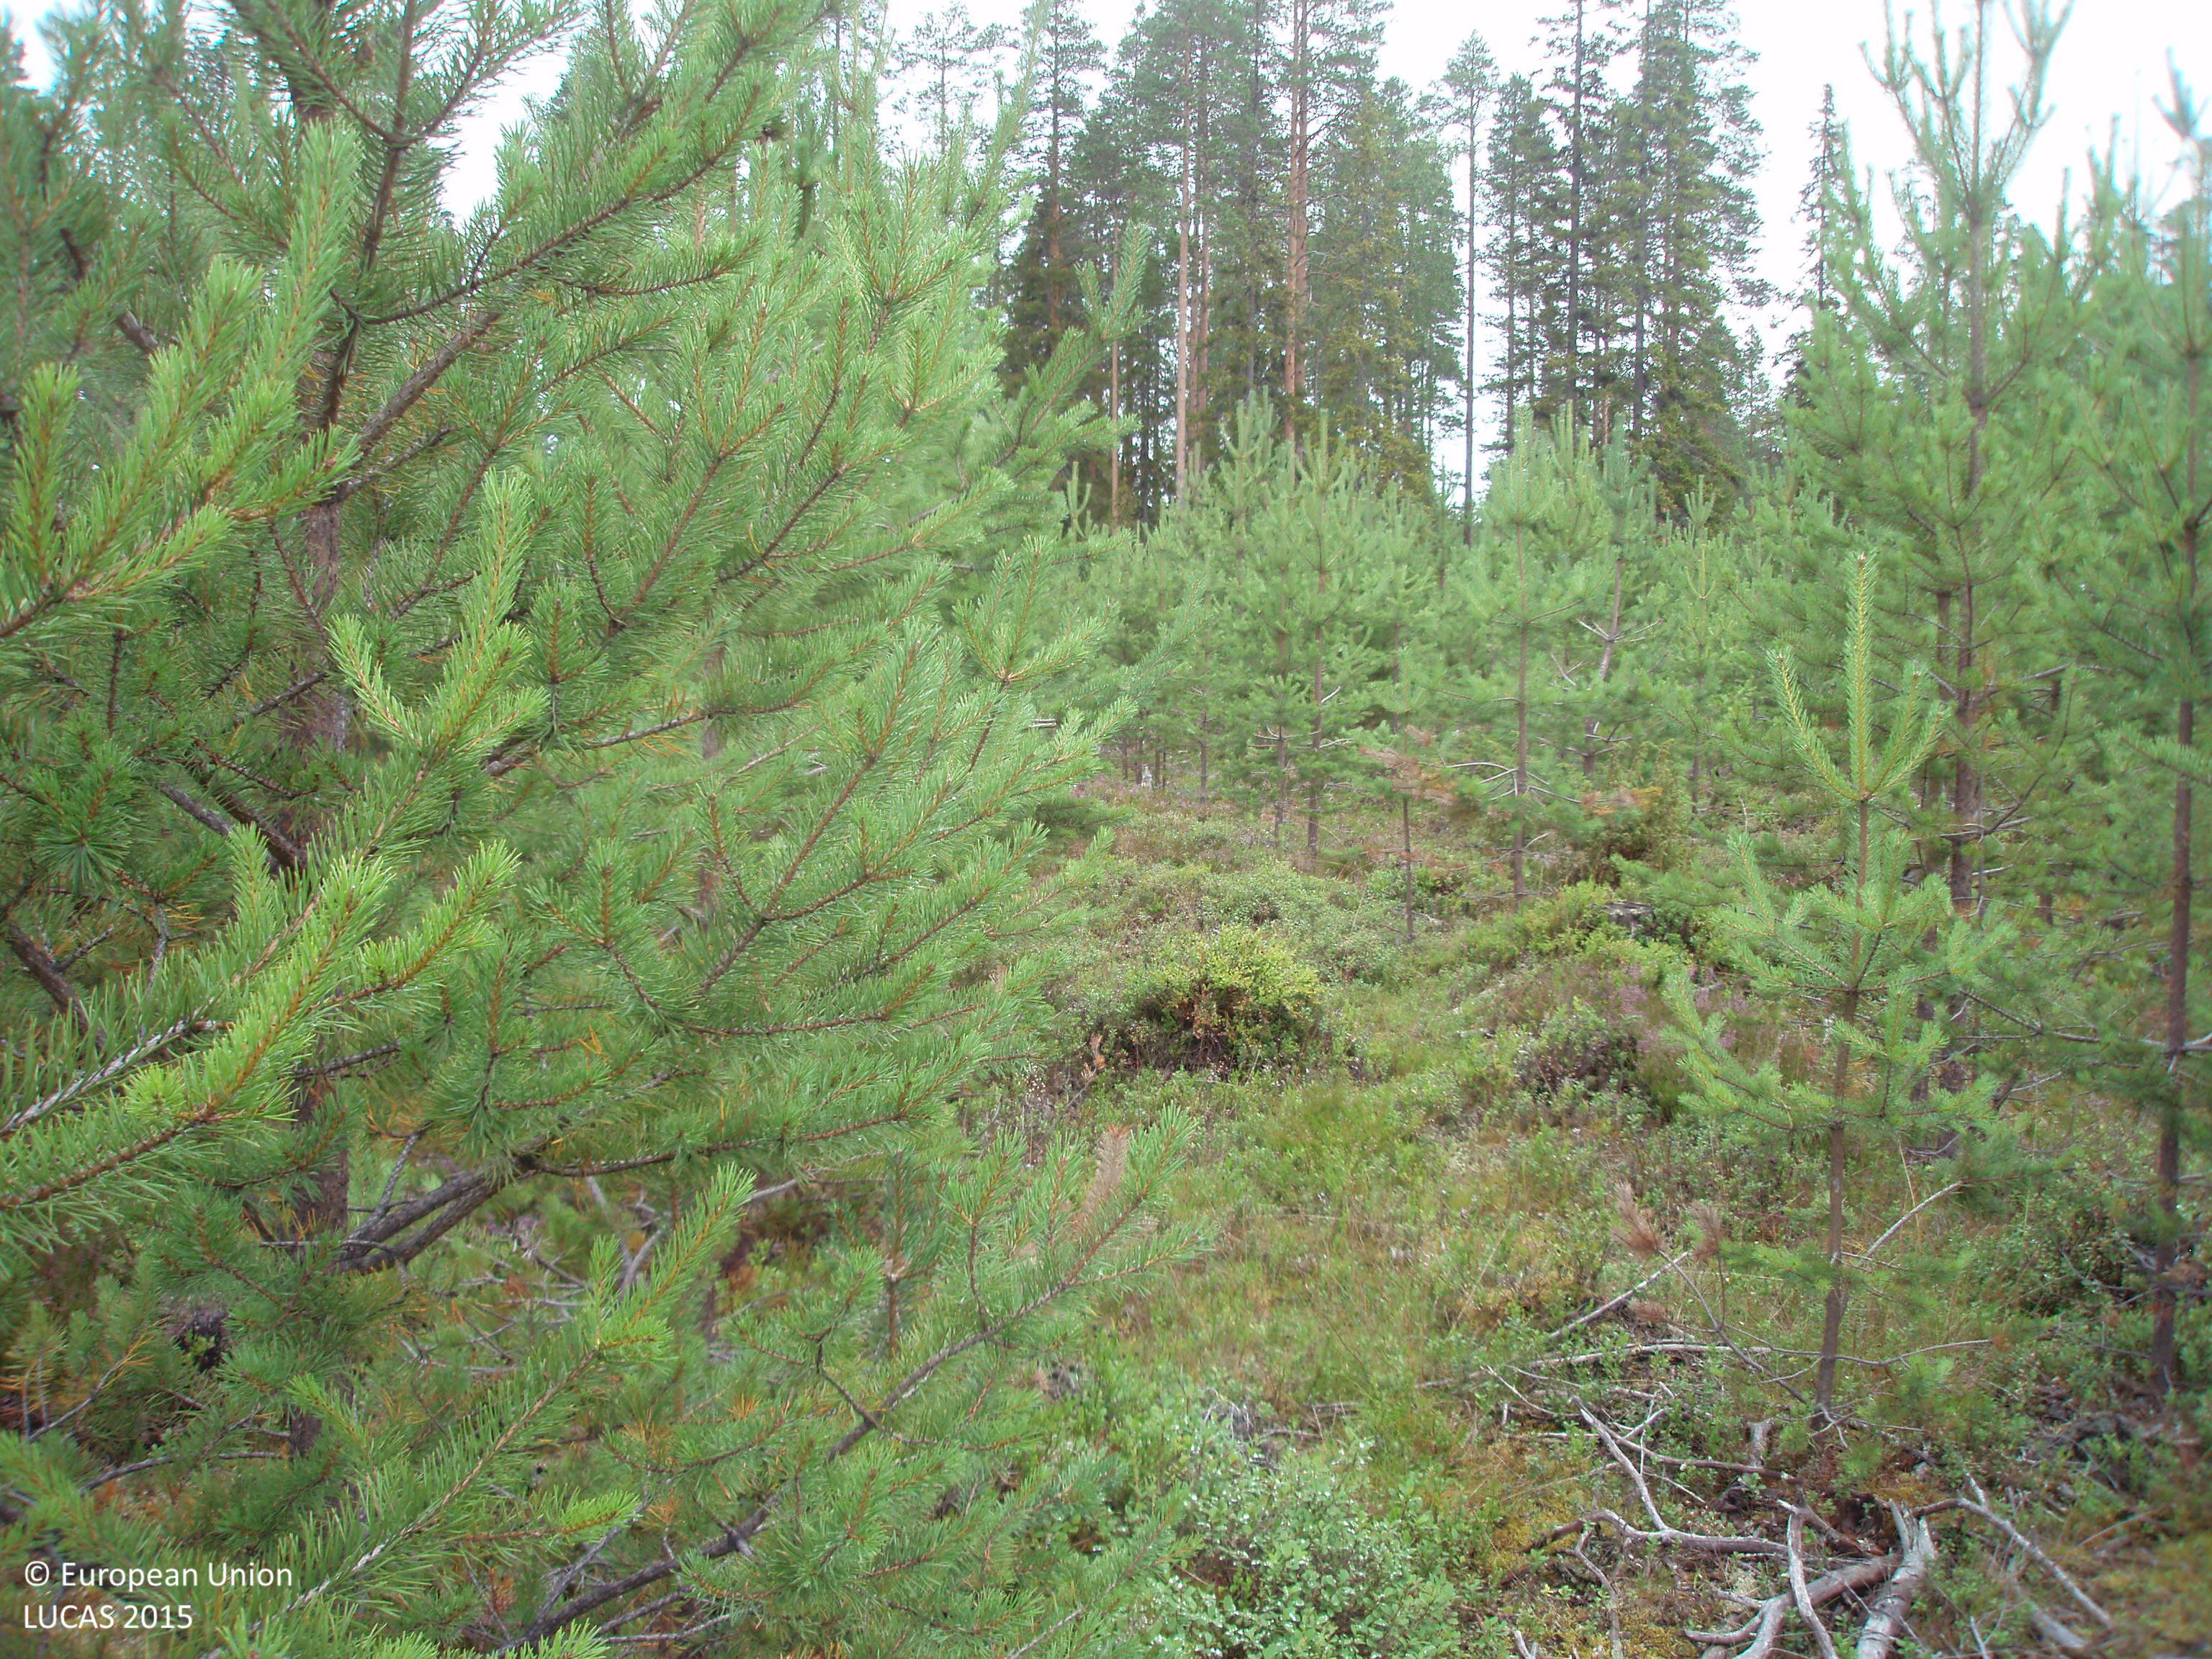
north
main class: Woodland
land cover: Pine dominated coniferous woodland
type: boreal forest
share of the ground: 25 - 50 %
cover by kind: shrubs 65 %, coniferous forest trees 35 %
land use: Forestry
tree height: < 5 m
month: August
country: FI
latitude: 65.4930
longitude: 27.0329
